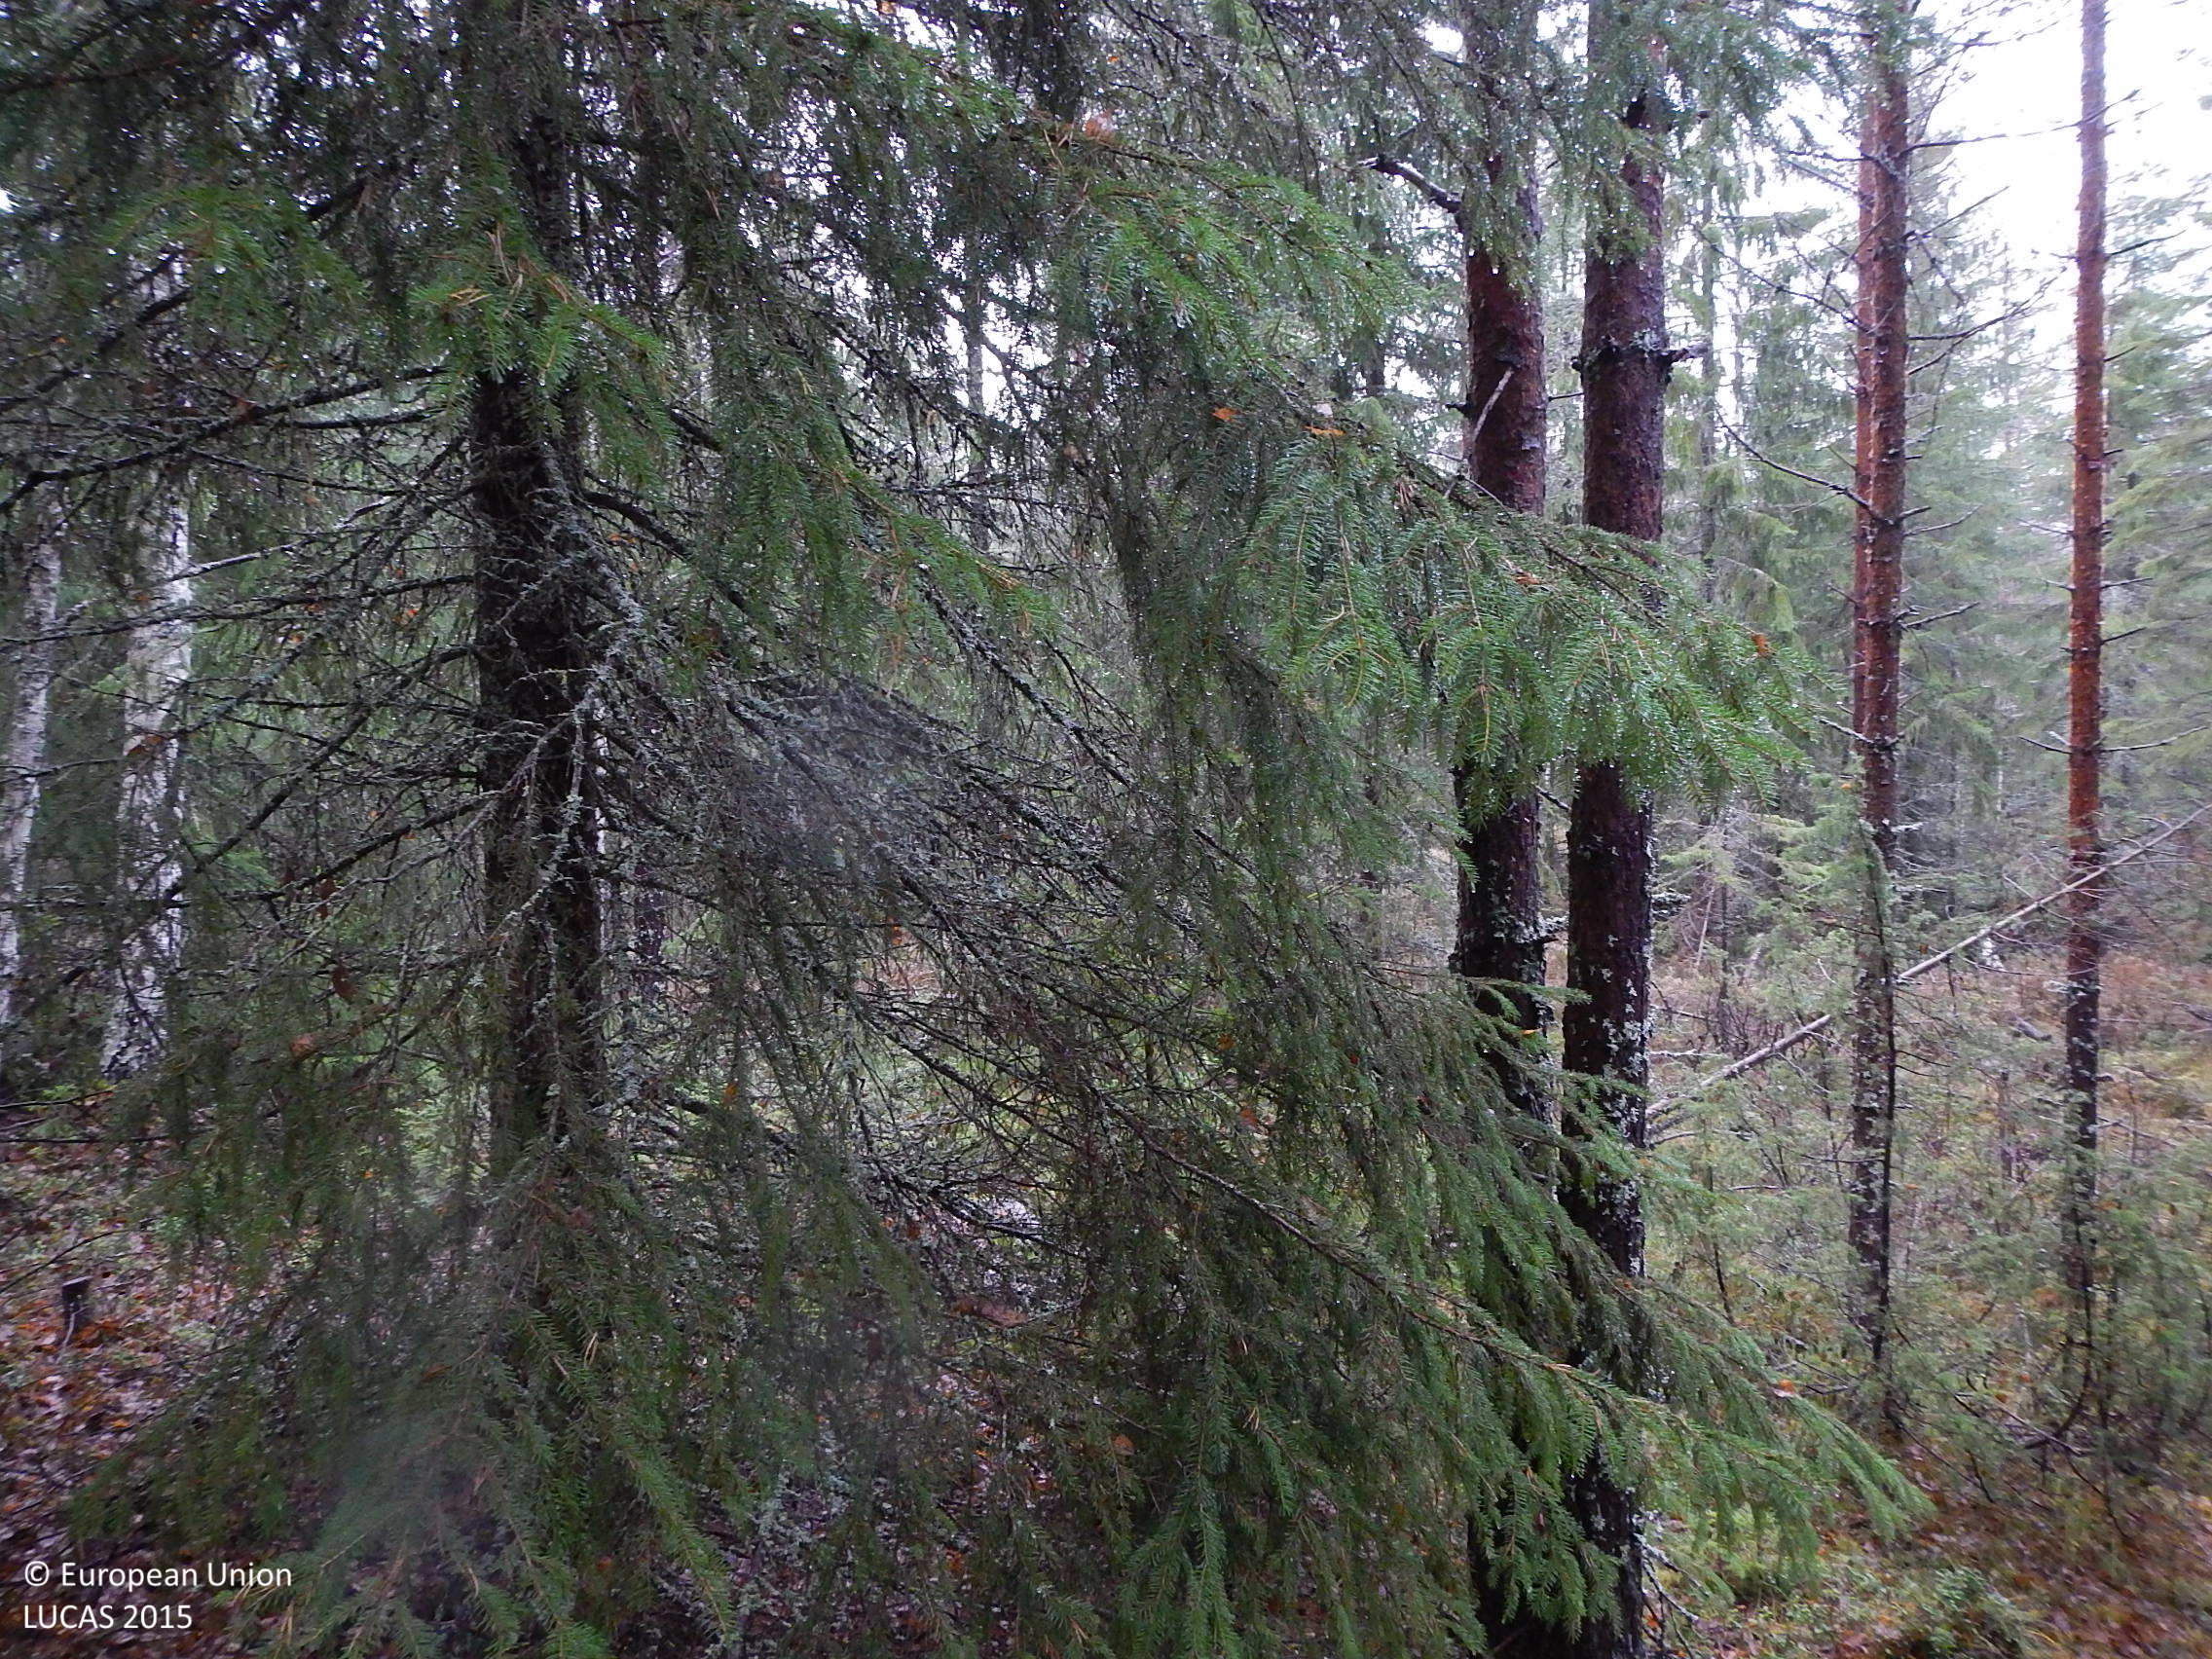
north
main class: Woodland
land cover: Other mixed woodland
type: boreal forest
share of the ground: > 75 %
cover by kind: coniferous forest trees 45 %, broadleaved forest trees 30 %, shrubs 10 %, lichens and mosses 10 %, herbaceous plants 5 %
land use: Forestry
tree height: > 5 m
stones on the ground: < 10 %
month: November
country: SE
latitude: 61.3774
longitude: 16.7029
